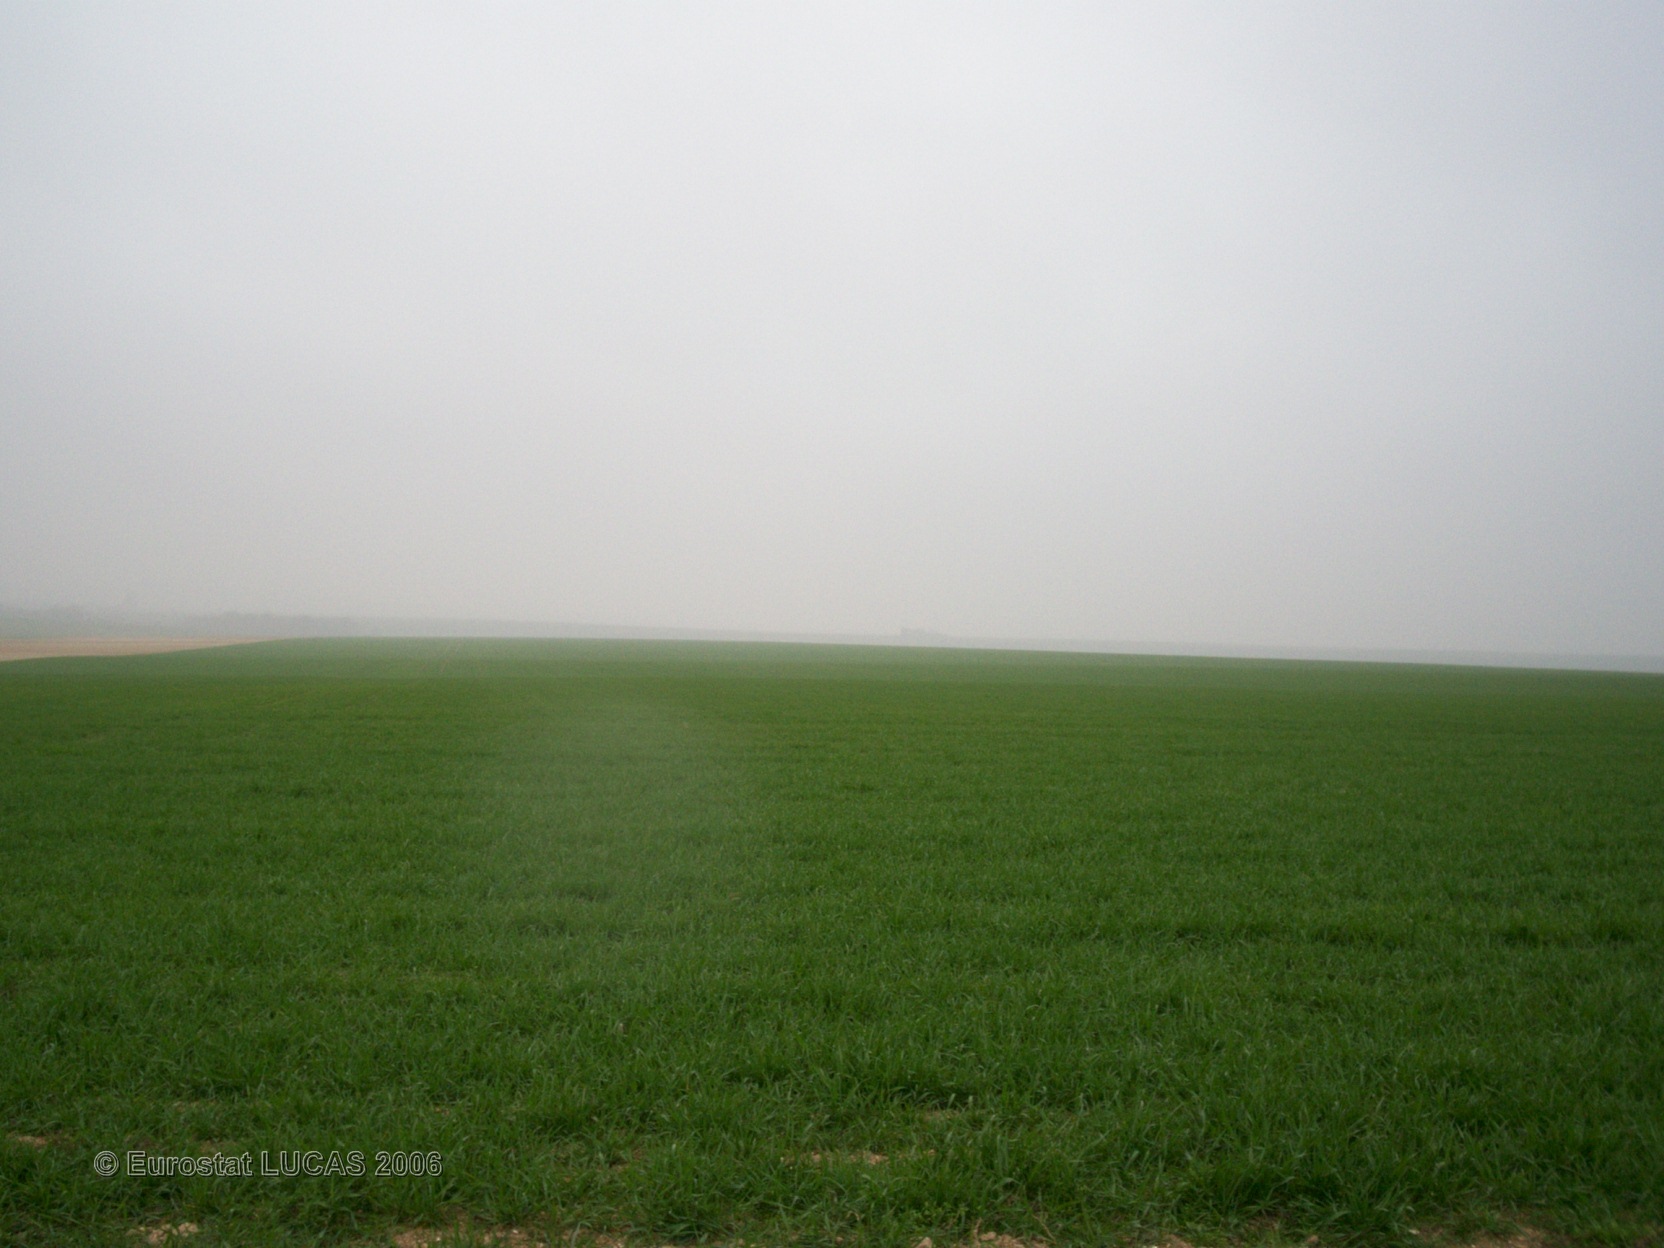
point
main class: Cropland
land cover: Common wheat
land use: Agriculture (excluding fallow land and kitchen gardens)
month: April
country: FR
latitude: 49.2564
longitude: 4.4592
